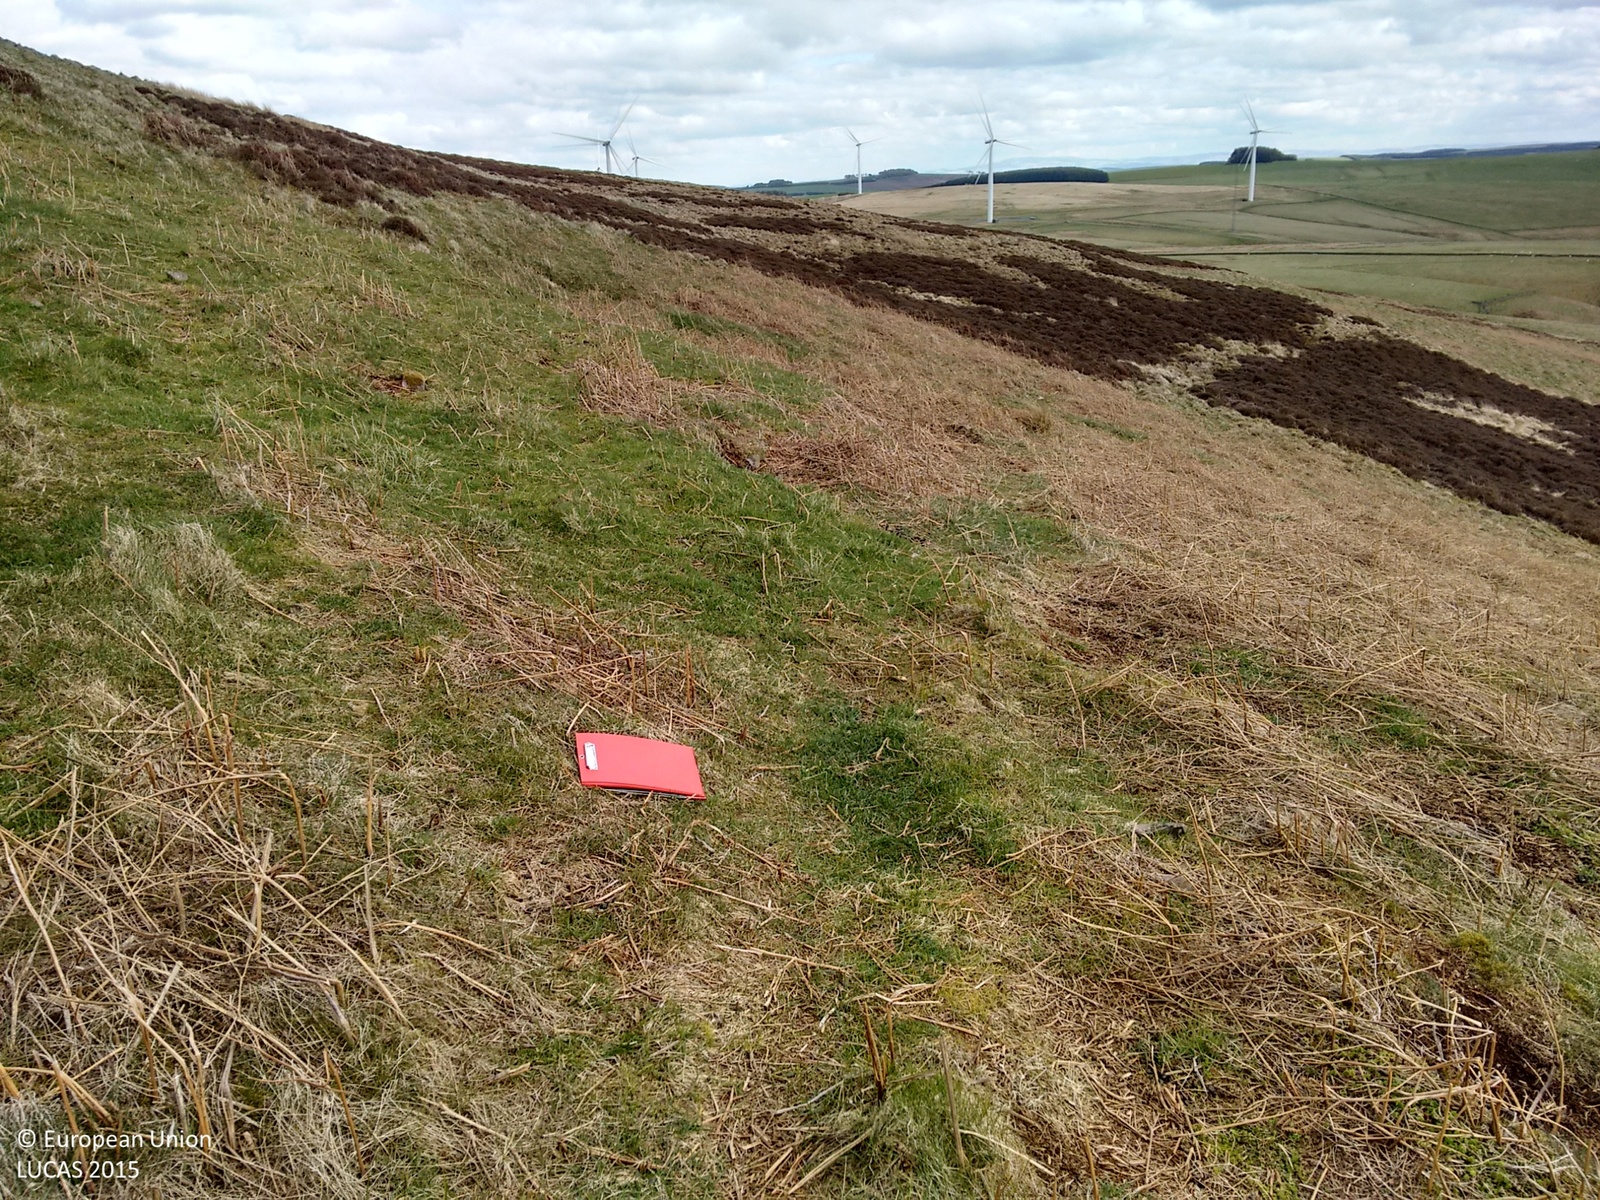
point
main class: Grassland
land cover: Grassland without tree/shrub cover
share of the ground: > 75 %
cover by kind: herbaceous plants 95 %, shrubs 5 %
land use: Agriculture (excluding fallow land and kitchen gardens)
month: May
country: GB
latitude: 55.7703
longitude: -2.8987
